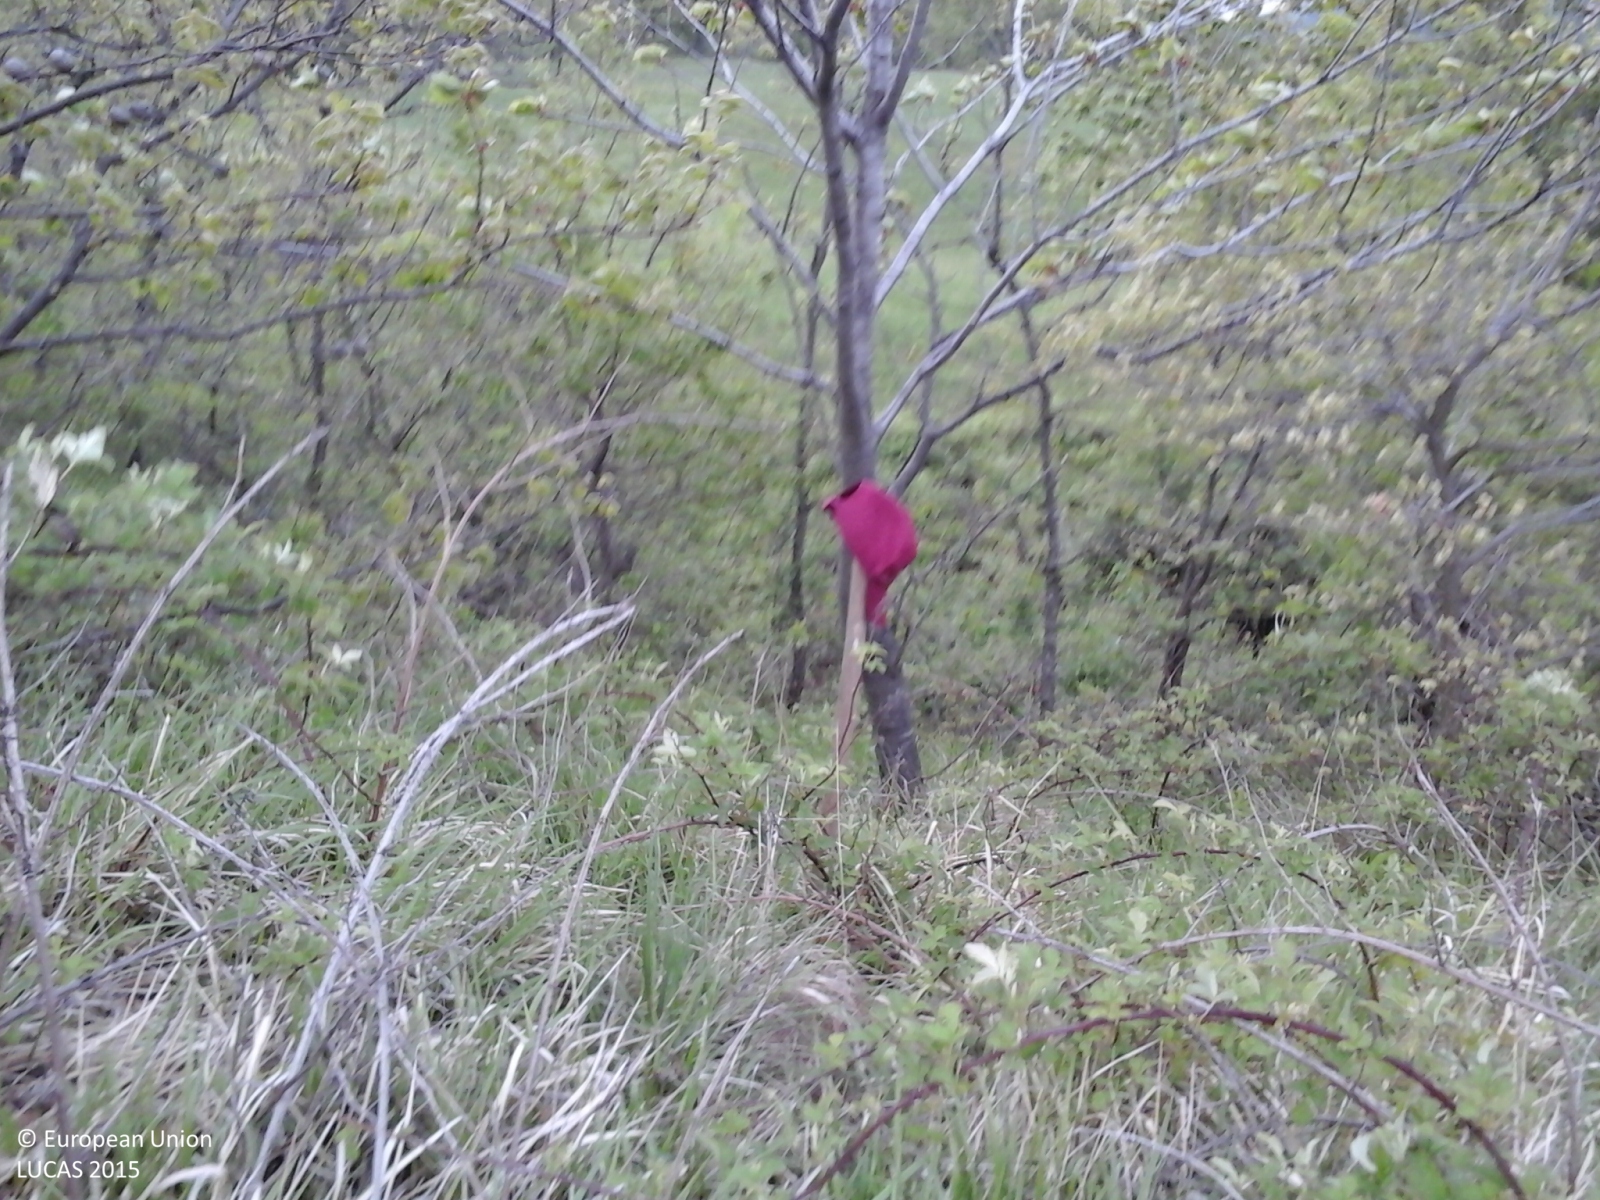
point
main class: Woodland
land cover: Broadleaved woodland
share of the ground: > 75 %
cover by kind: broadleaved forest trees 70 %, shrubs 20 %, herbaceous plants 10 %
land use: Forestry
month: May
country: IT
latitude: 44.8541
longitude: 9.4570
